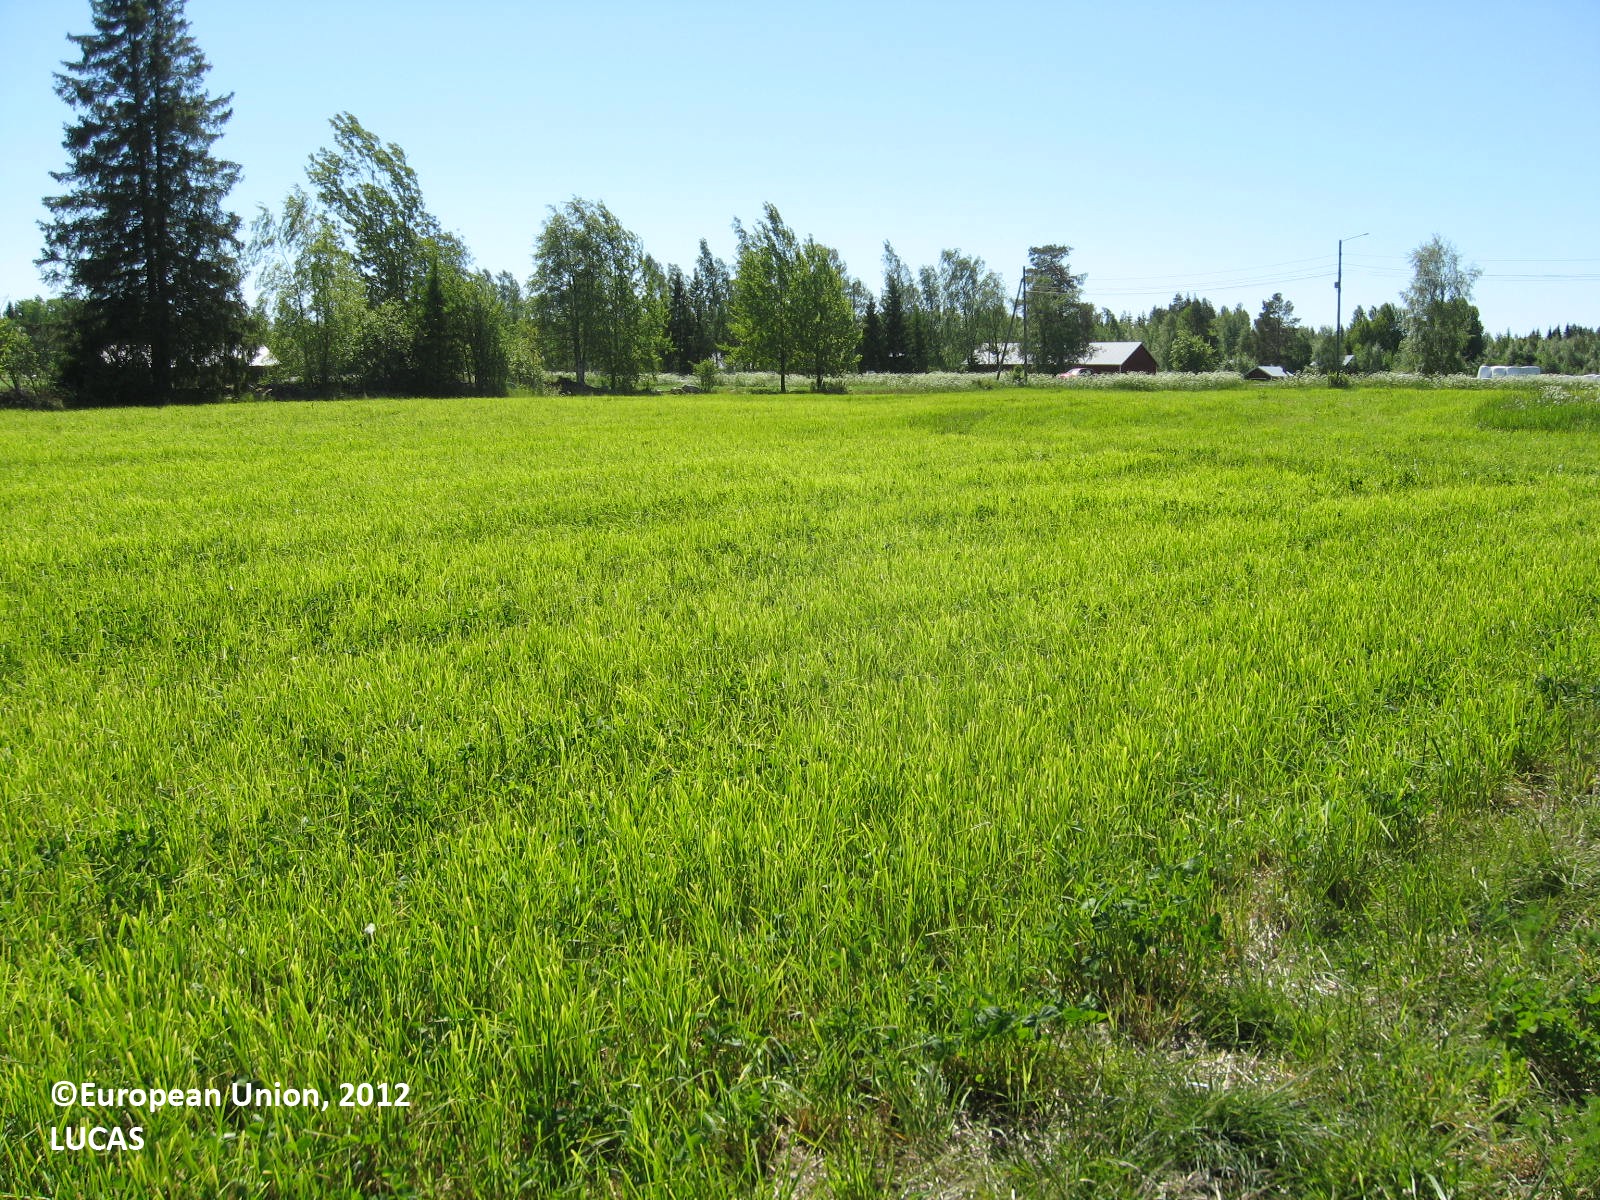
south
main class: Cropland
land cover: Other leguminous and mixtures for fodder
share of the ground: > 75 %
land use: Agriculture (excluding fallow land and kitchen gardens)
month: June
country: FI
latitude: 62.7901
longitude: 21.2713
